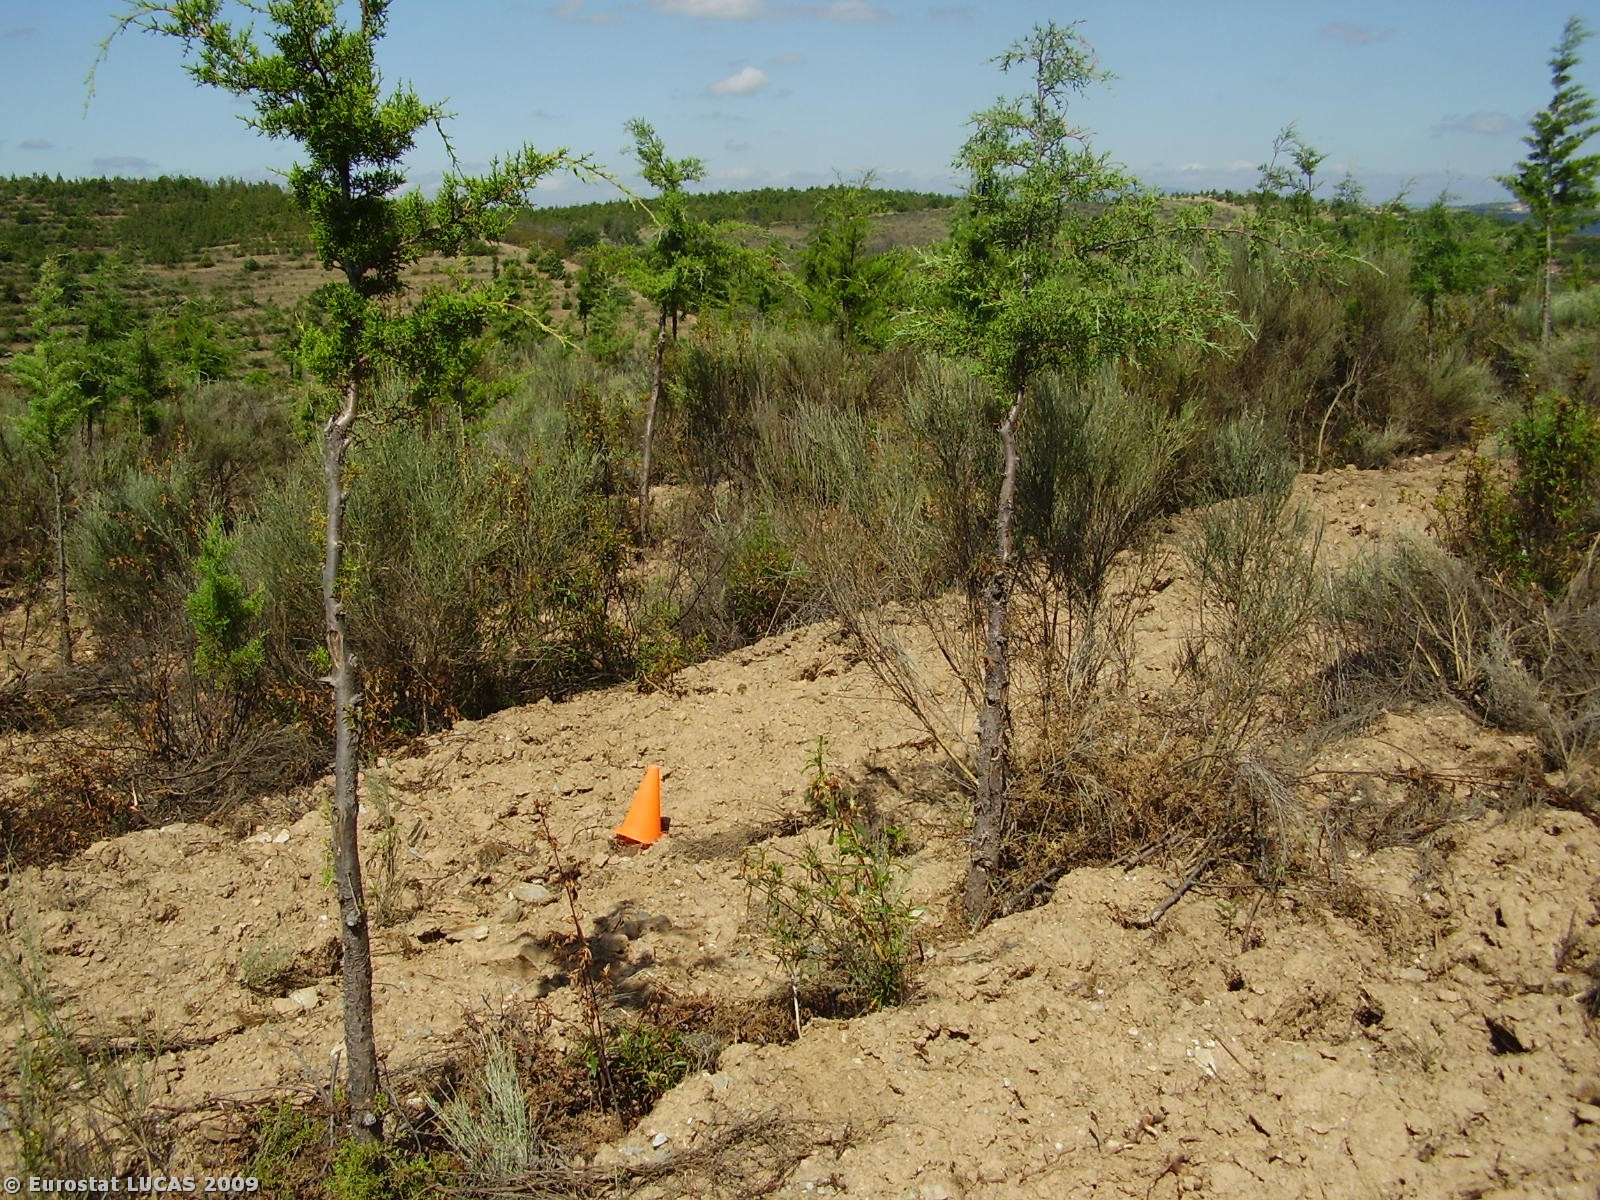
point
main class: Woodland
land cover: Coniferous woodland
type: coniferous forest of the mediterranean region
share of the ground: 10 - 25 %
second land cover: Spontaneously vegetated surfaces
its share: 10 - 25 %
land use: Forestry
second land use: Unused
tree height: > 5 m
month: June
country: PT
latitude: 41.6153
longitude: -6.5342
